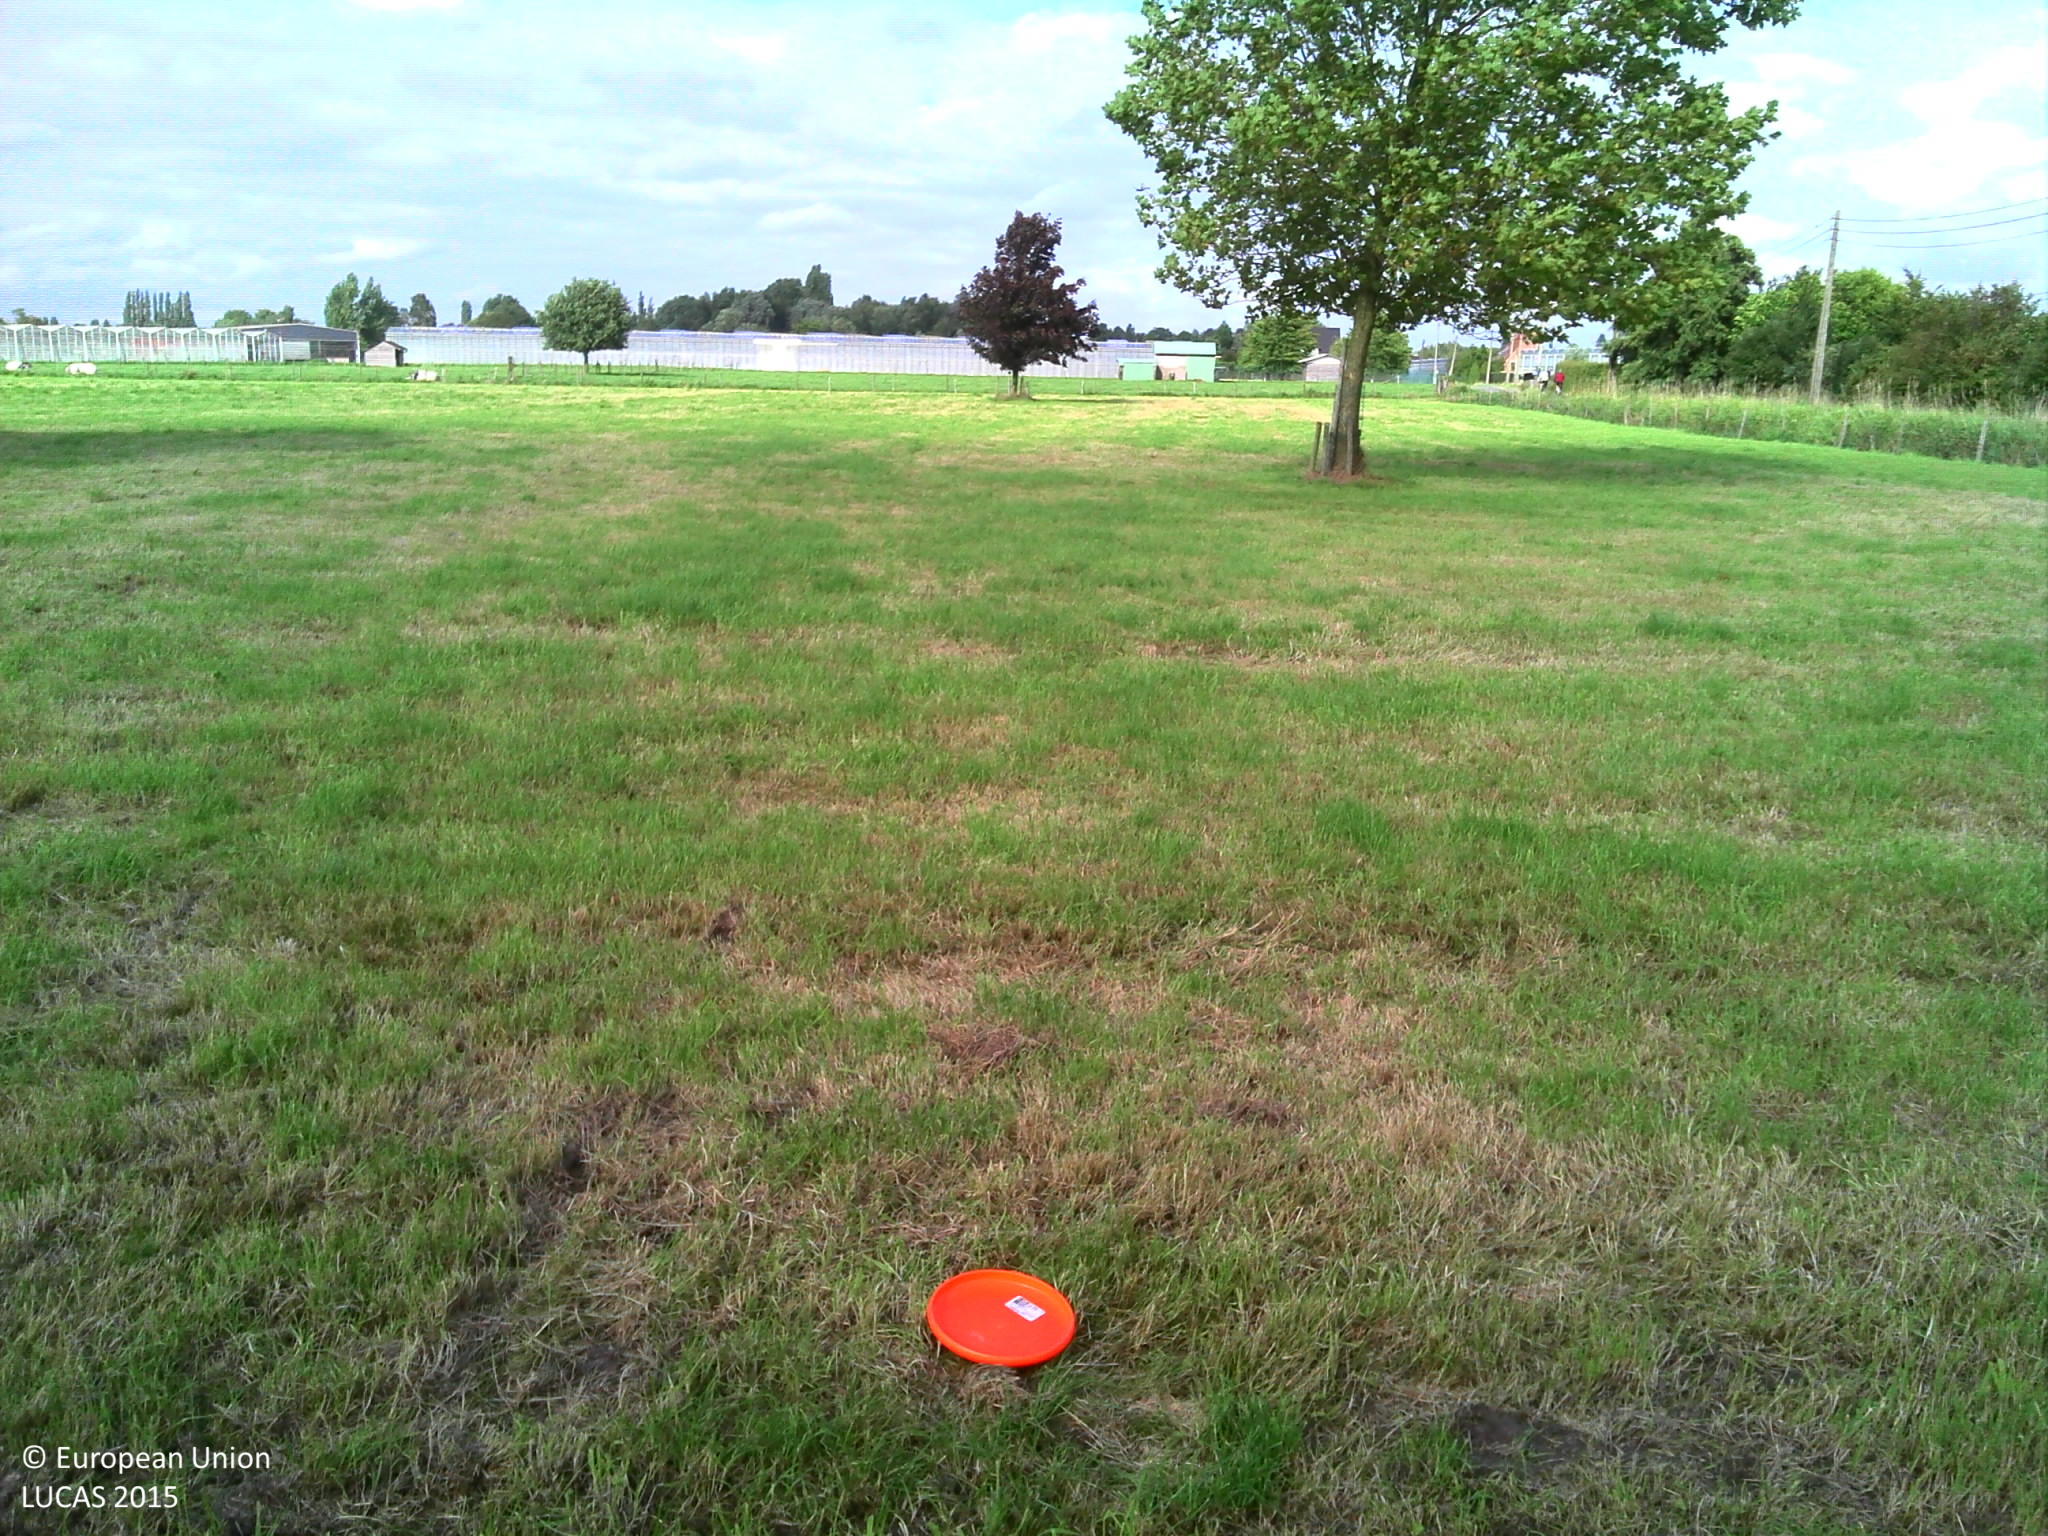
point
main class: Grassland
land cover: Grassland without tree/shrub cover
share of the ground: > 75 %
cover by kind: herbaceous plants 100 %
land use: Agriculture (excluding fallow land and kitchen gardens)
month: September
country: BE
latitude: 51.1877
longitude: 4.5160
